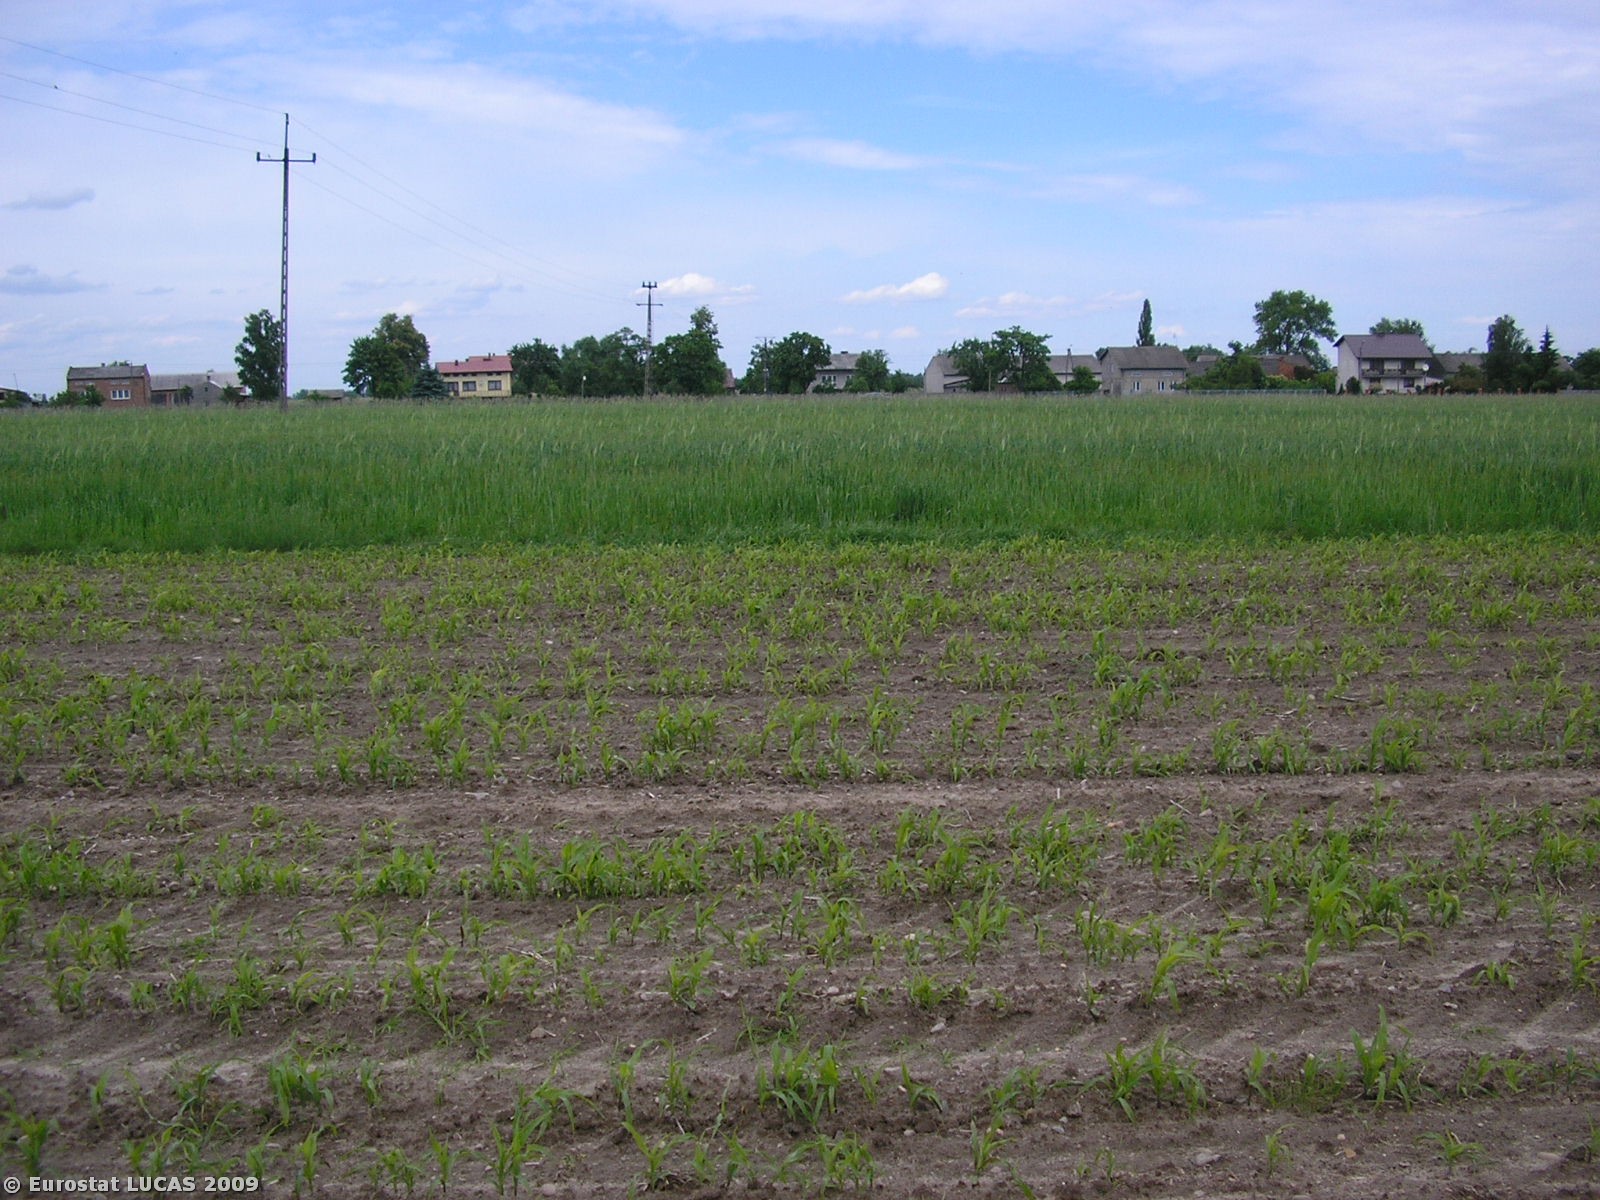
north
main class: Cropland
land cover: Maize
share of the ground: 10 - 25 %
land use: Agriculture (excluding fallow land and kitchen gardens)
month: June
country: PL
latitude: 51.3344
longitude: 18.9363
